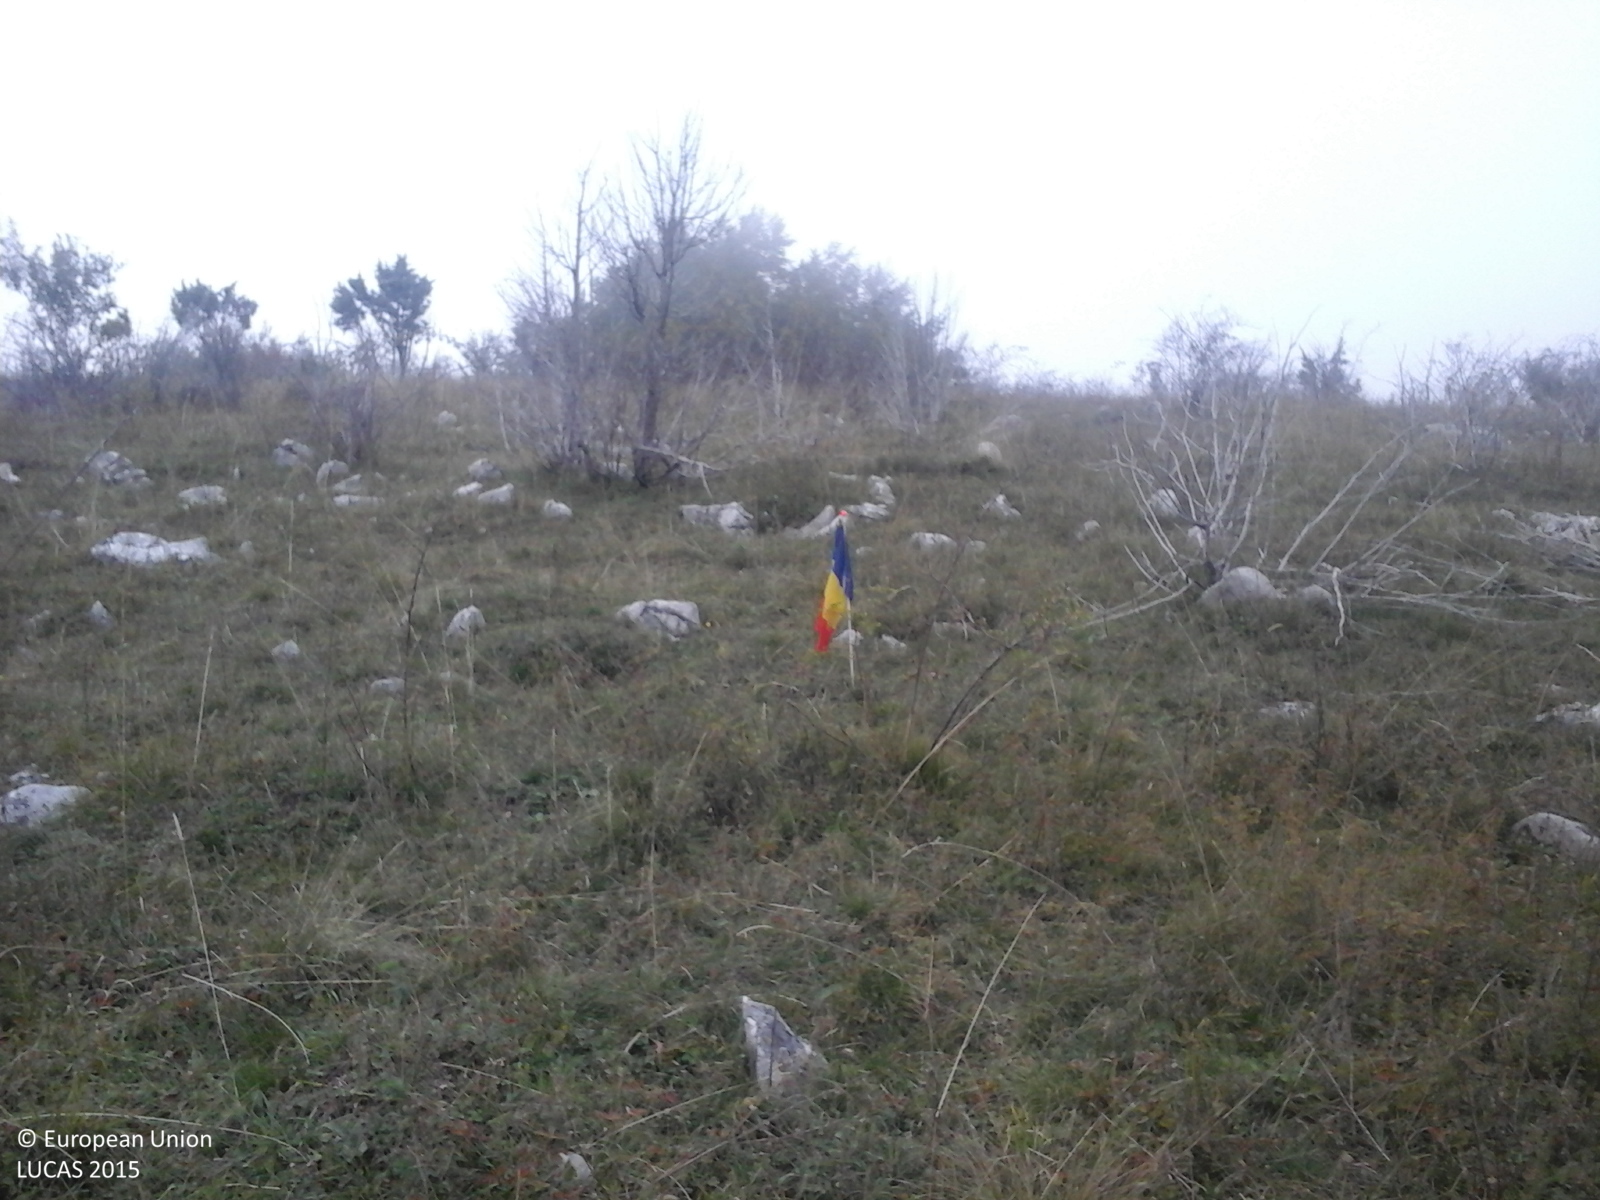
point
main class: Grassland
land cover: Grassland with sparse tree/shrub cover
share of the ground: > 75 %
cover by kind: herbaceous plants 95 %, broadleaved forest trees 5 %
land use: Agriculture (excluding fallow land and kitchen gardens)
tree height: > 5 m
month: October
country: RO
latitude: 46.3321
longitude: 23.4854
